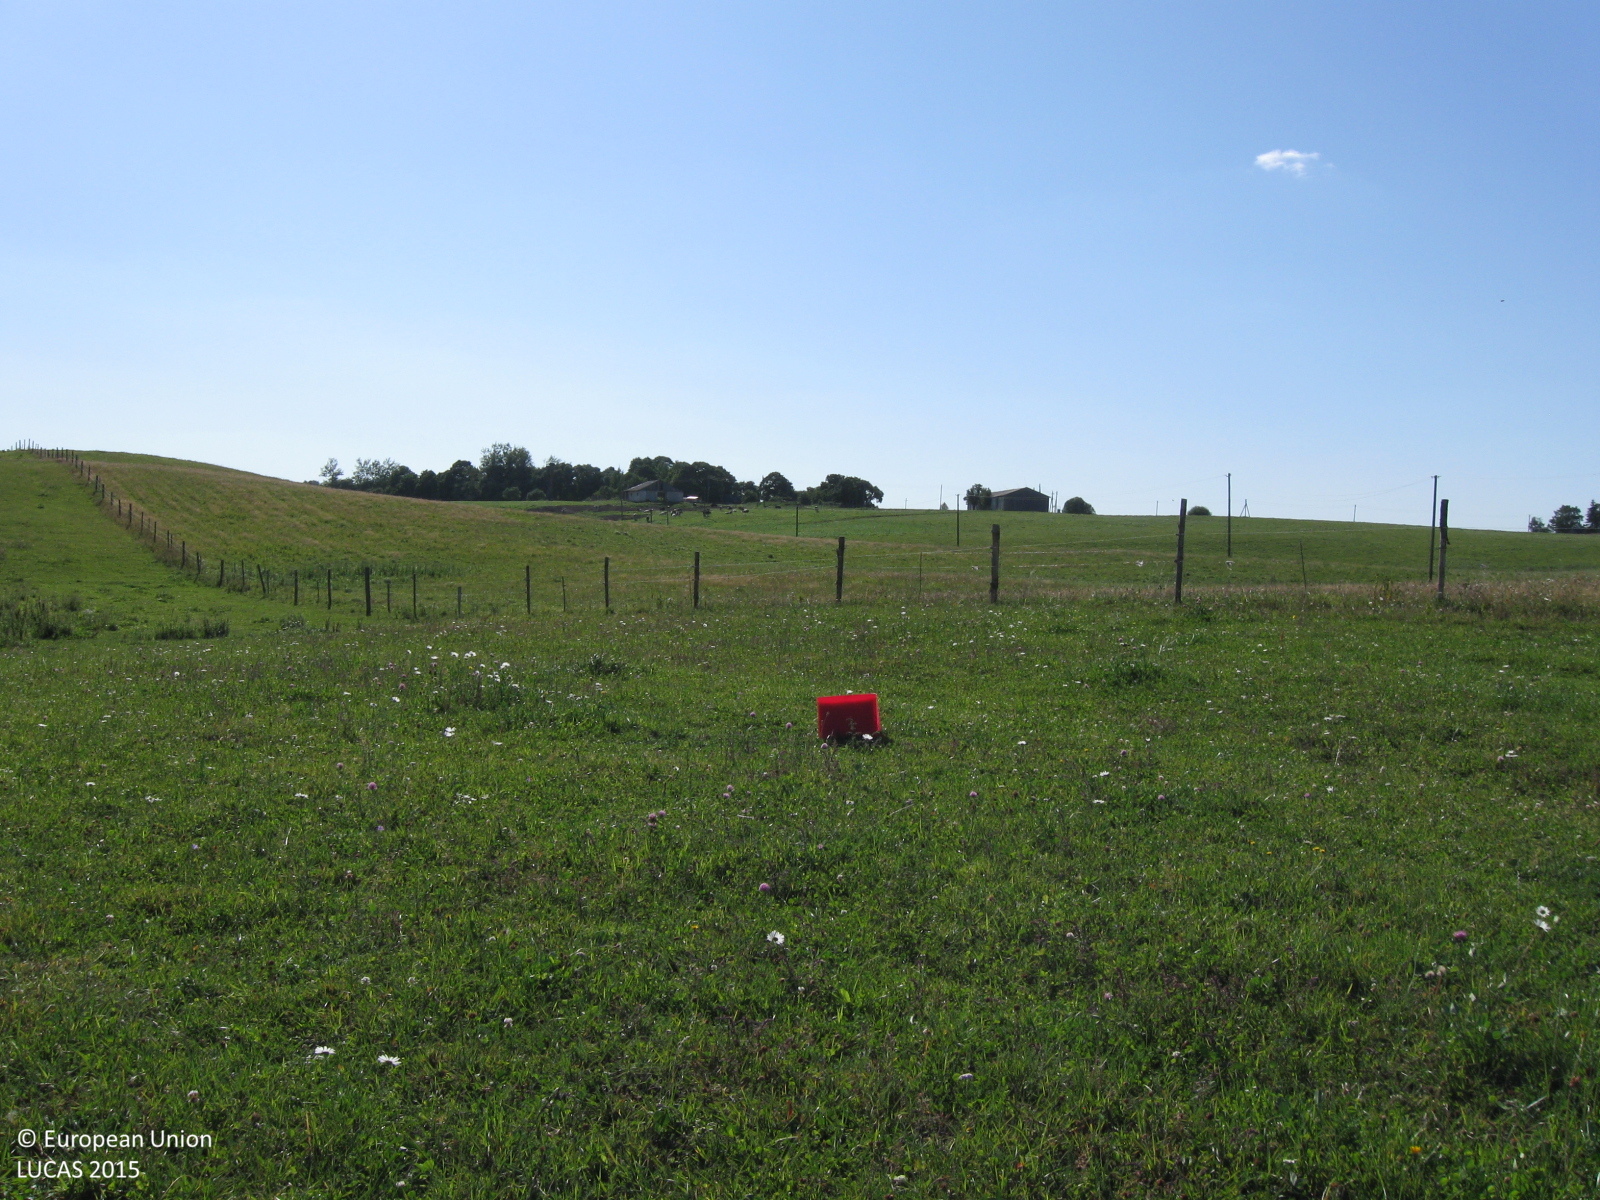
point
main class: Grassland
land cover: Grassland without tree/shrub cover
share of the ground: > 75 %
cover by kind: herbaceous plants 100 %
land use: Agriculture (excluding fallow land and kitchen gardens)
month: August
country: LT
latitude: 55.5340
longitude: 22.5309
